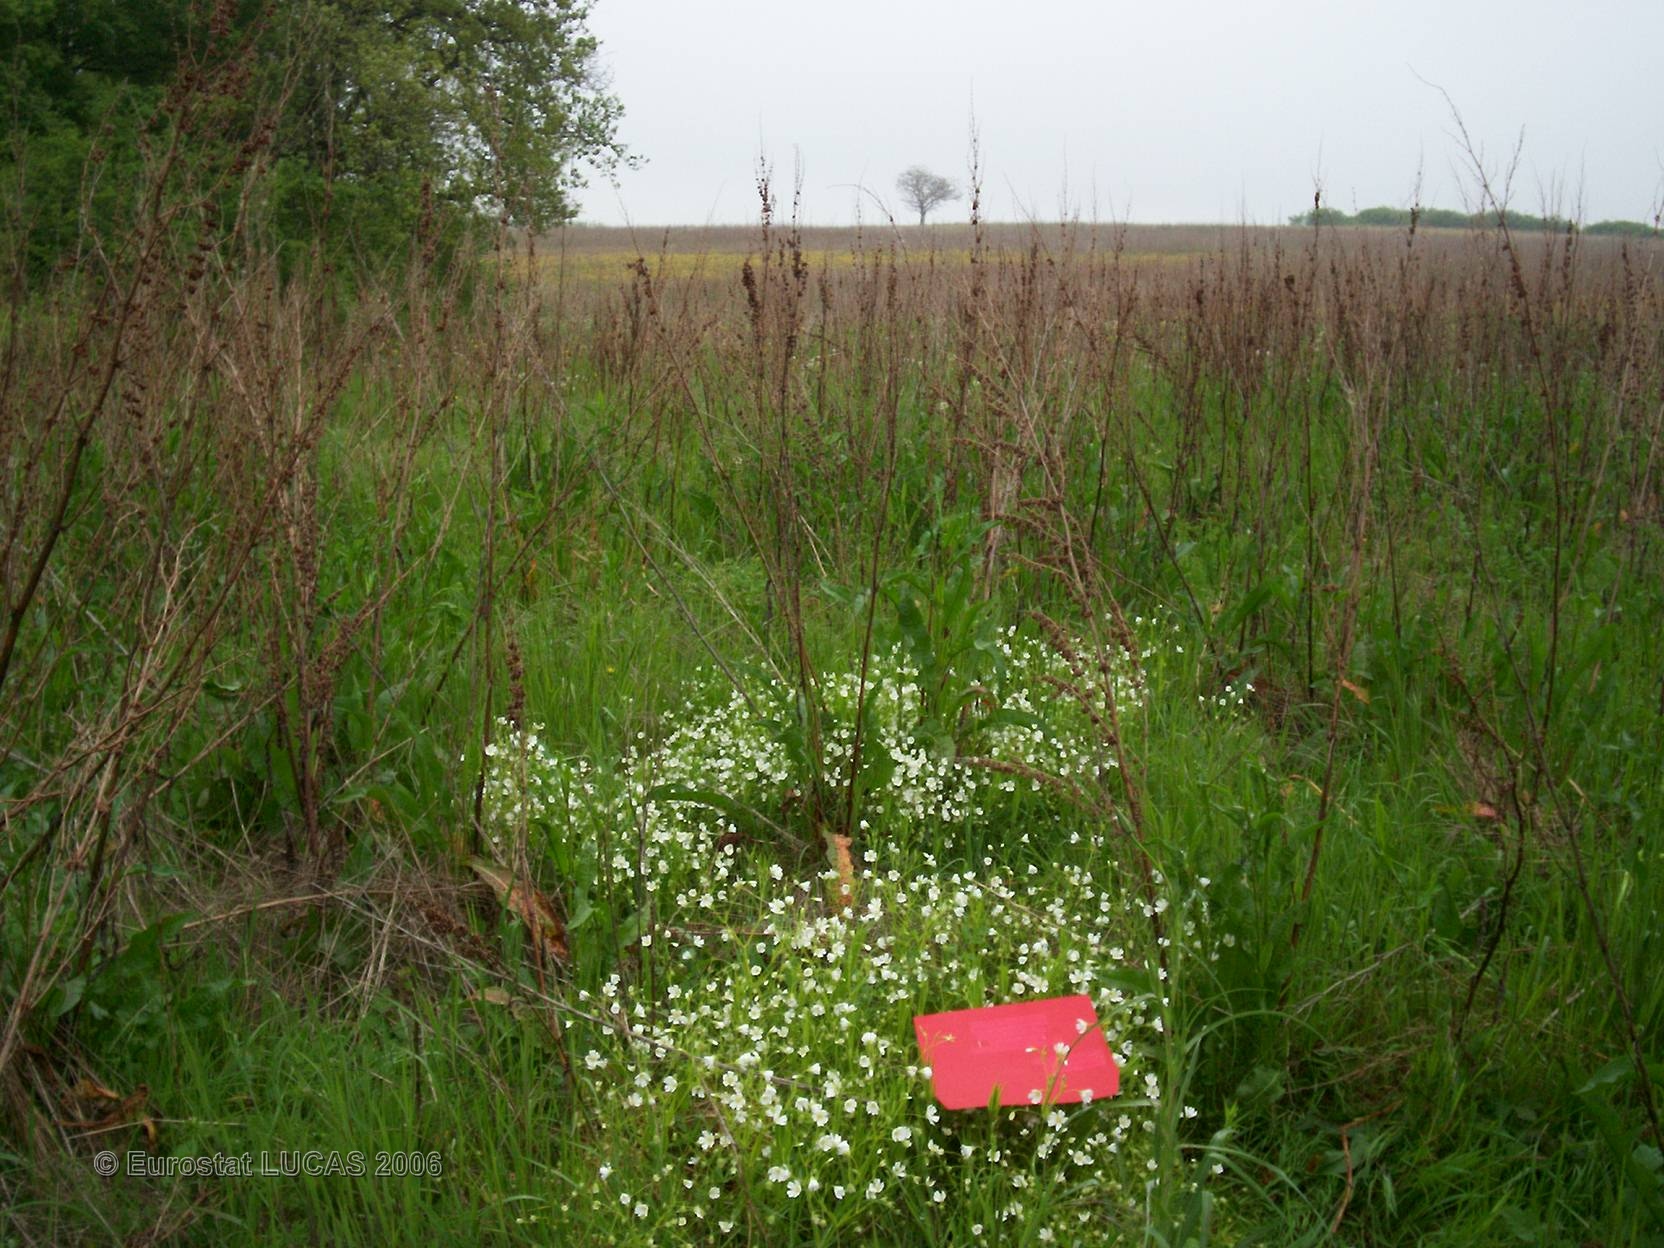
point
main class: Grassland
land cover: Grassland without tree/shrub cover
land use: Fallow land
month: April
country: FR
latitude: 44.2039
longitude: 0.8989
